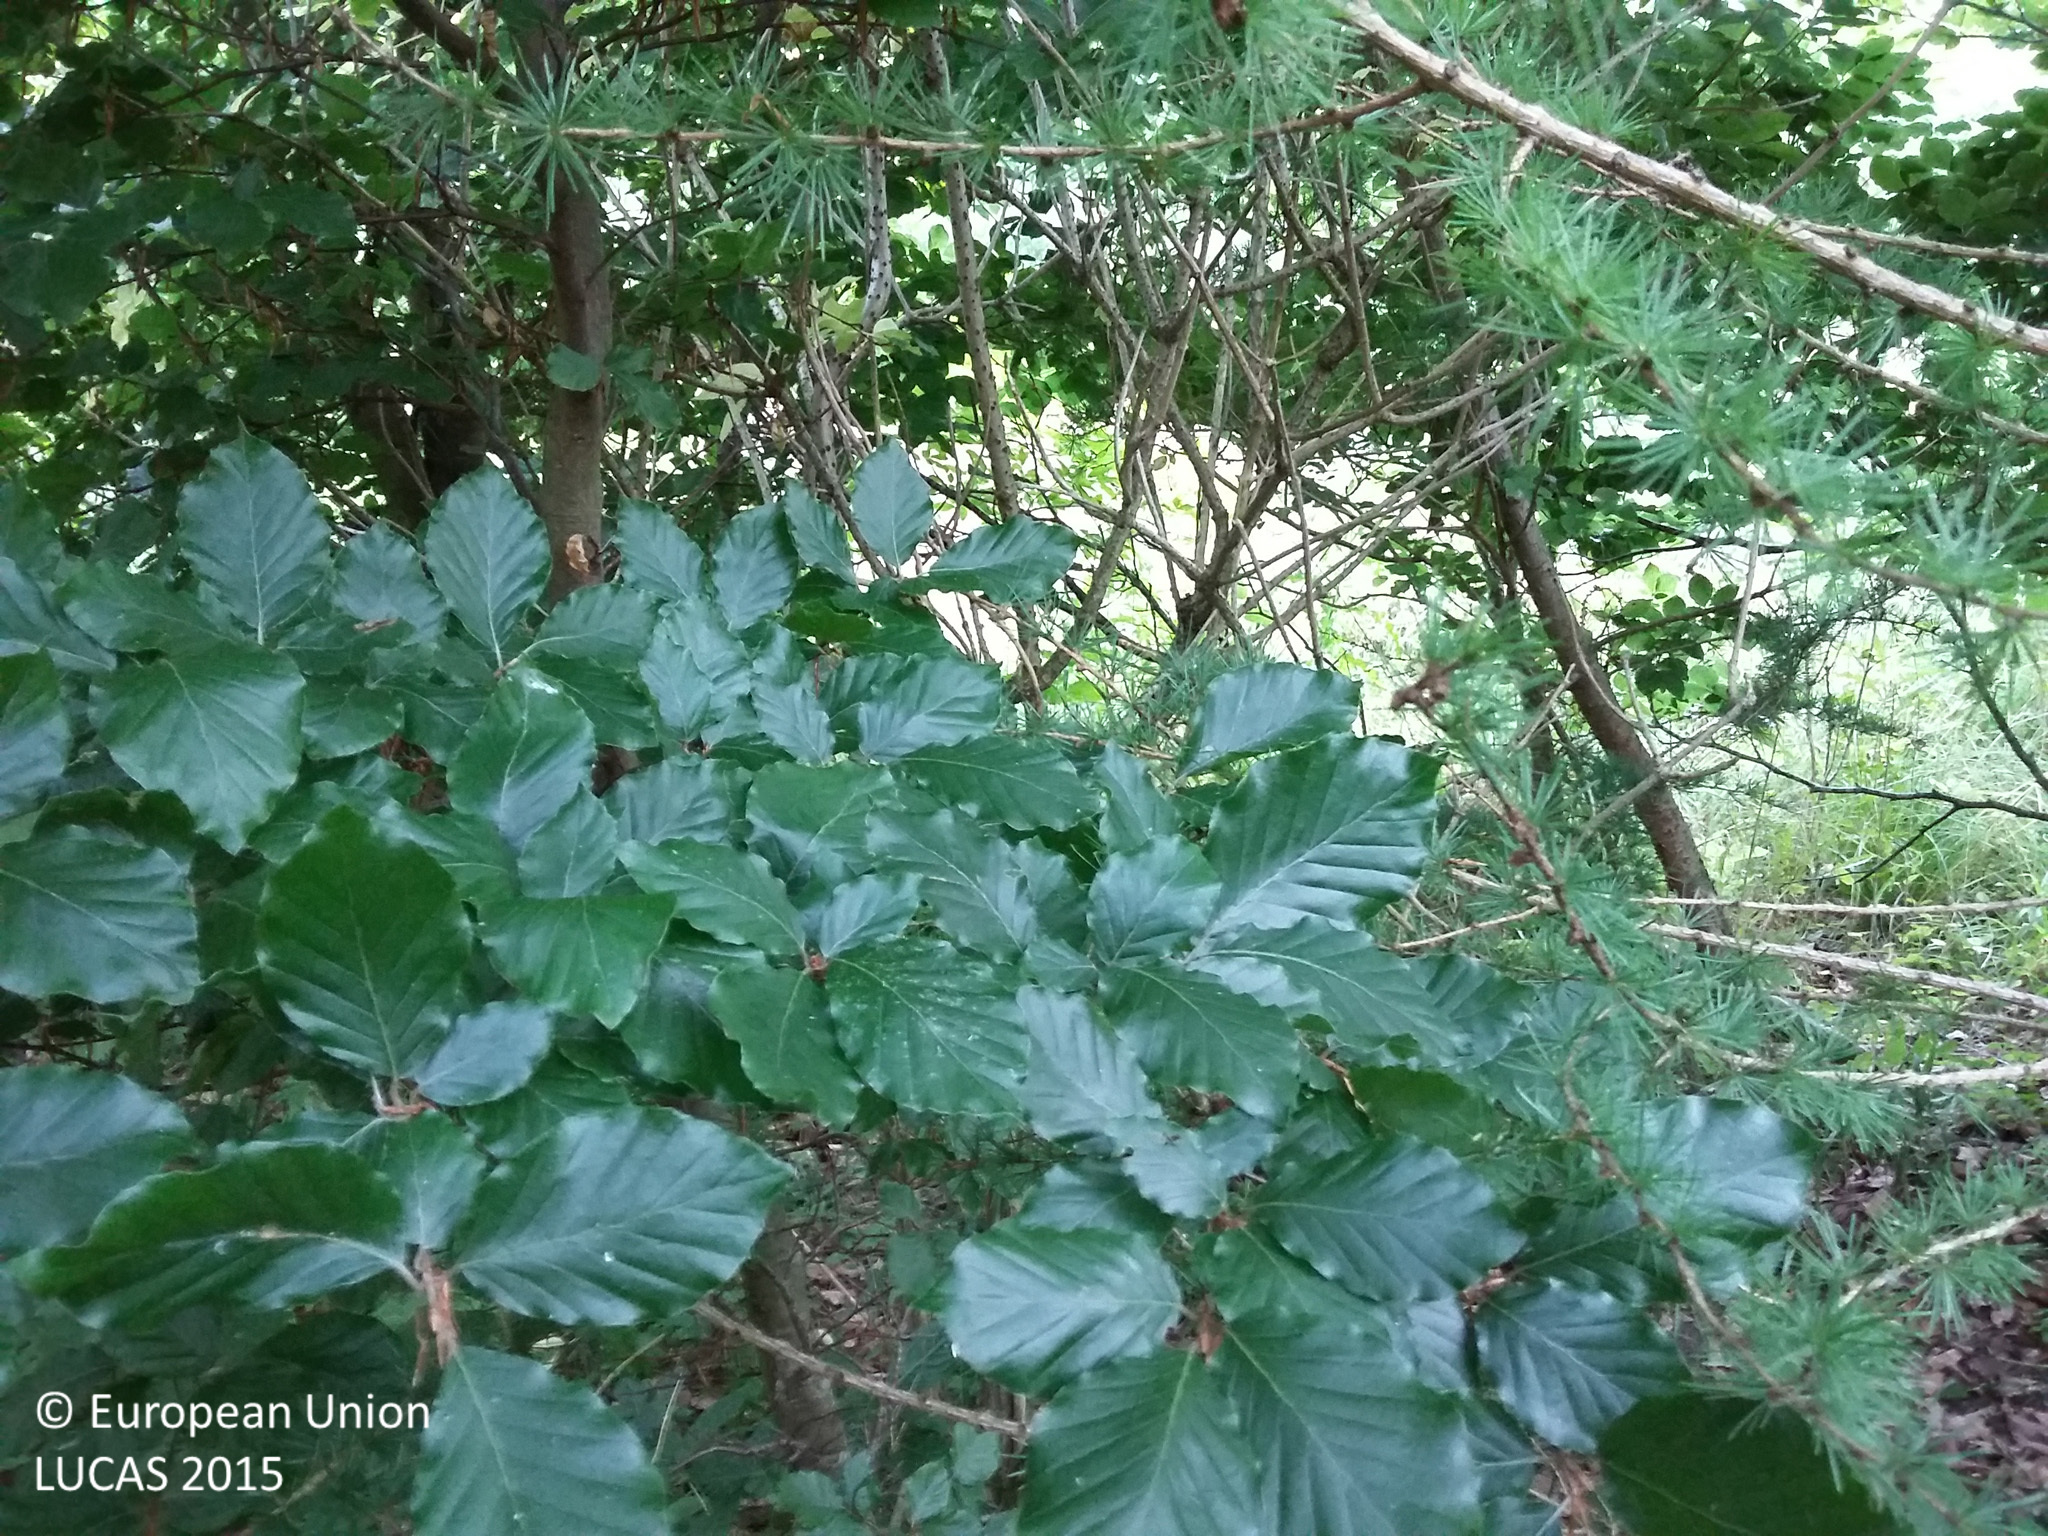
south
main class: Woodland
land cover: Other mixed woodland
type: beech forest
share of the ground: > 75 %
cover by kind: coniferous forest trees 50 %, broadleaved forest trees 40 %, shrubs 5 %, herbaceous plants 5 %
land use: Forestry
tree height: > 5 m
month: August
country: DK
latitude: 55.3625
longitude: 12.0335
